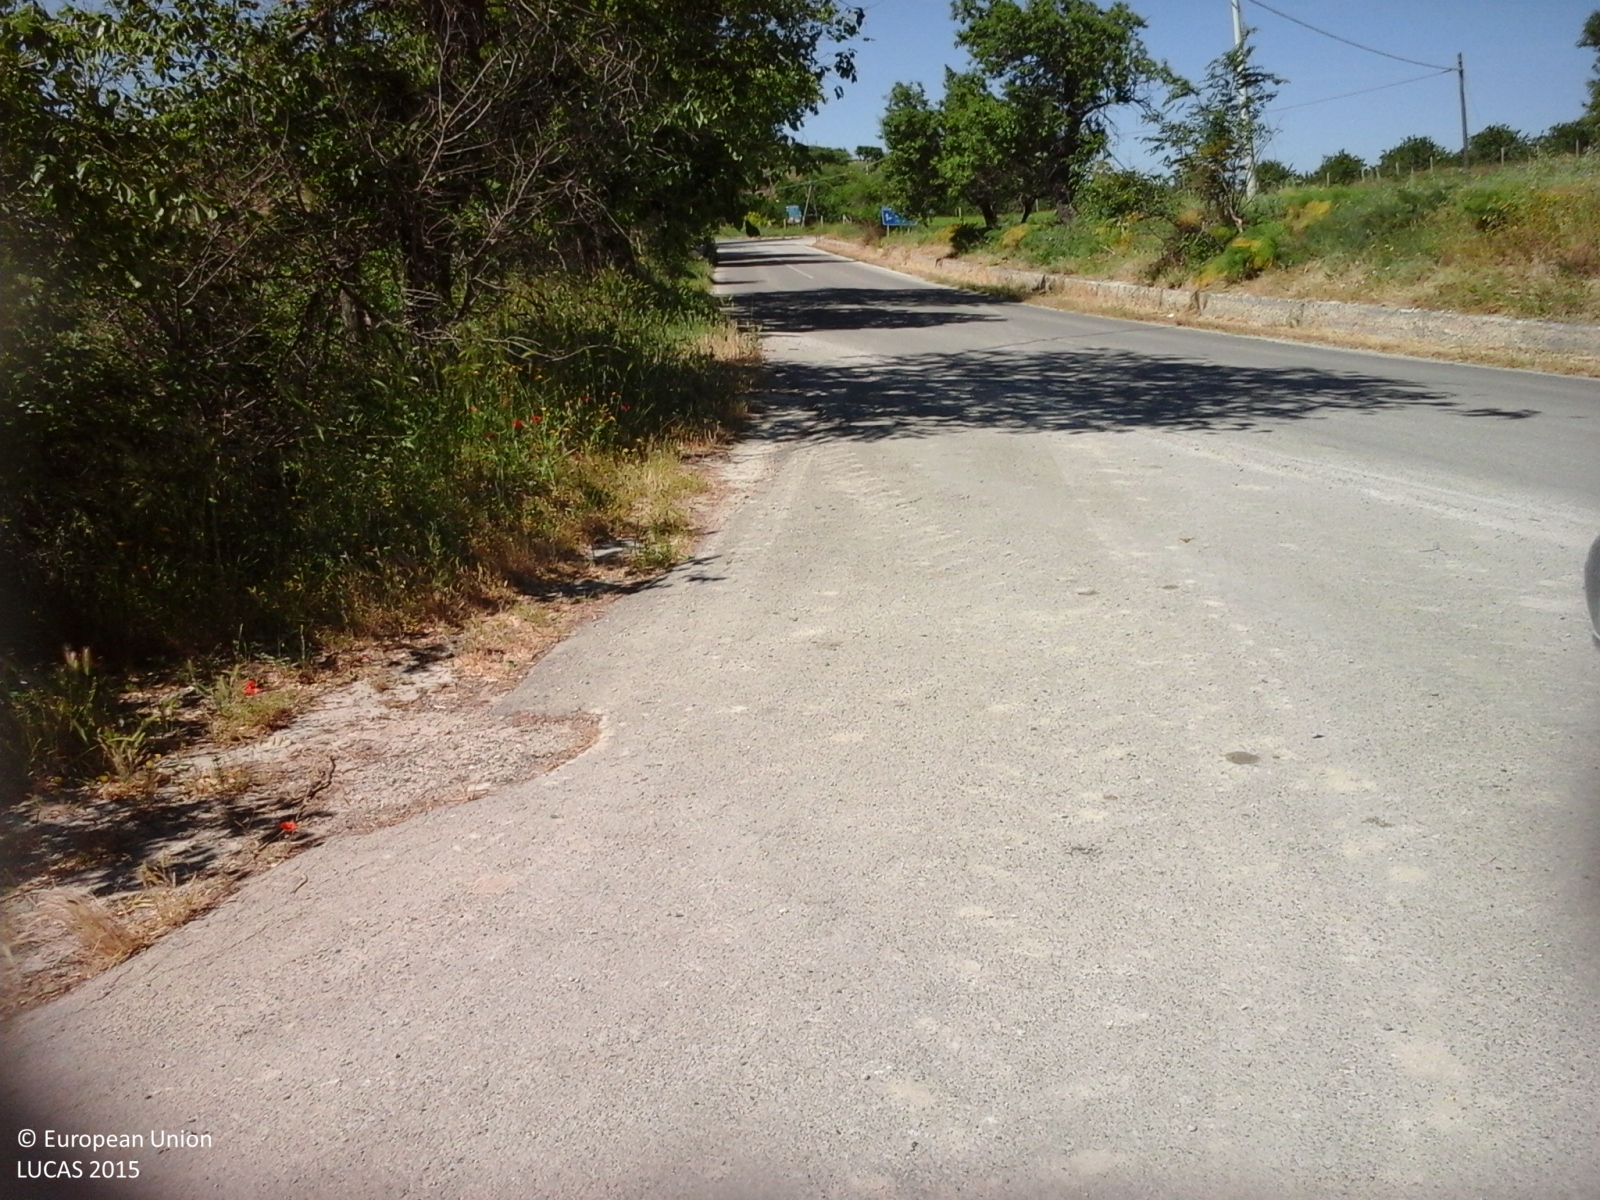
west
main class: Cropland
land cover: Vineyards
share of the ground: > 75 %
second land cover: Other bare soil
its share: > 75 %
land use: Agriculture (excluding fallow land and kitchen gardens)
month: May
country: IT
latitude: 37.4279
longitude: 13.9816
